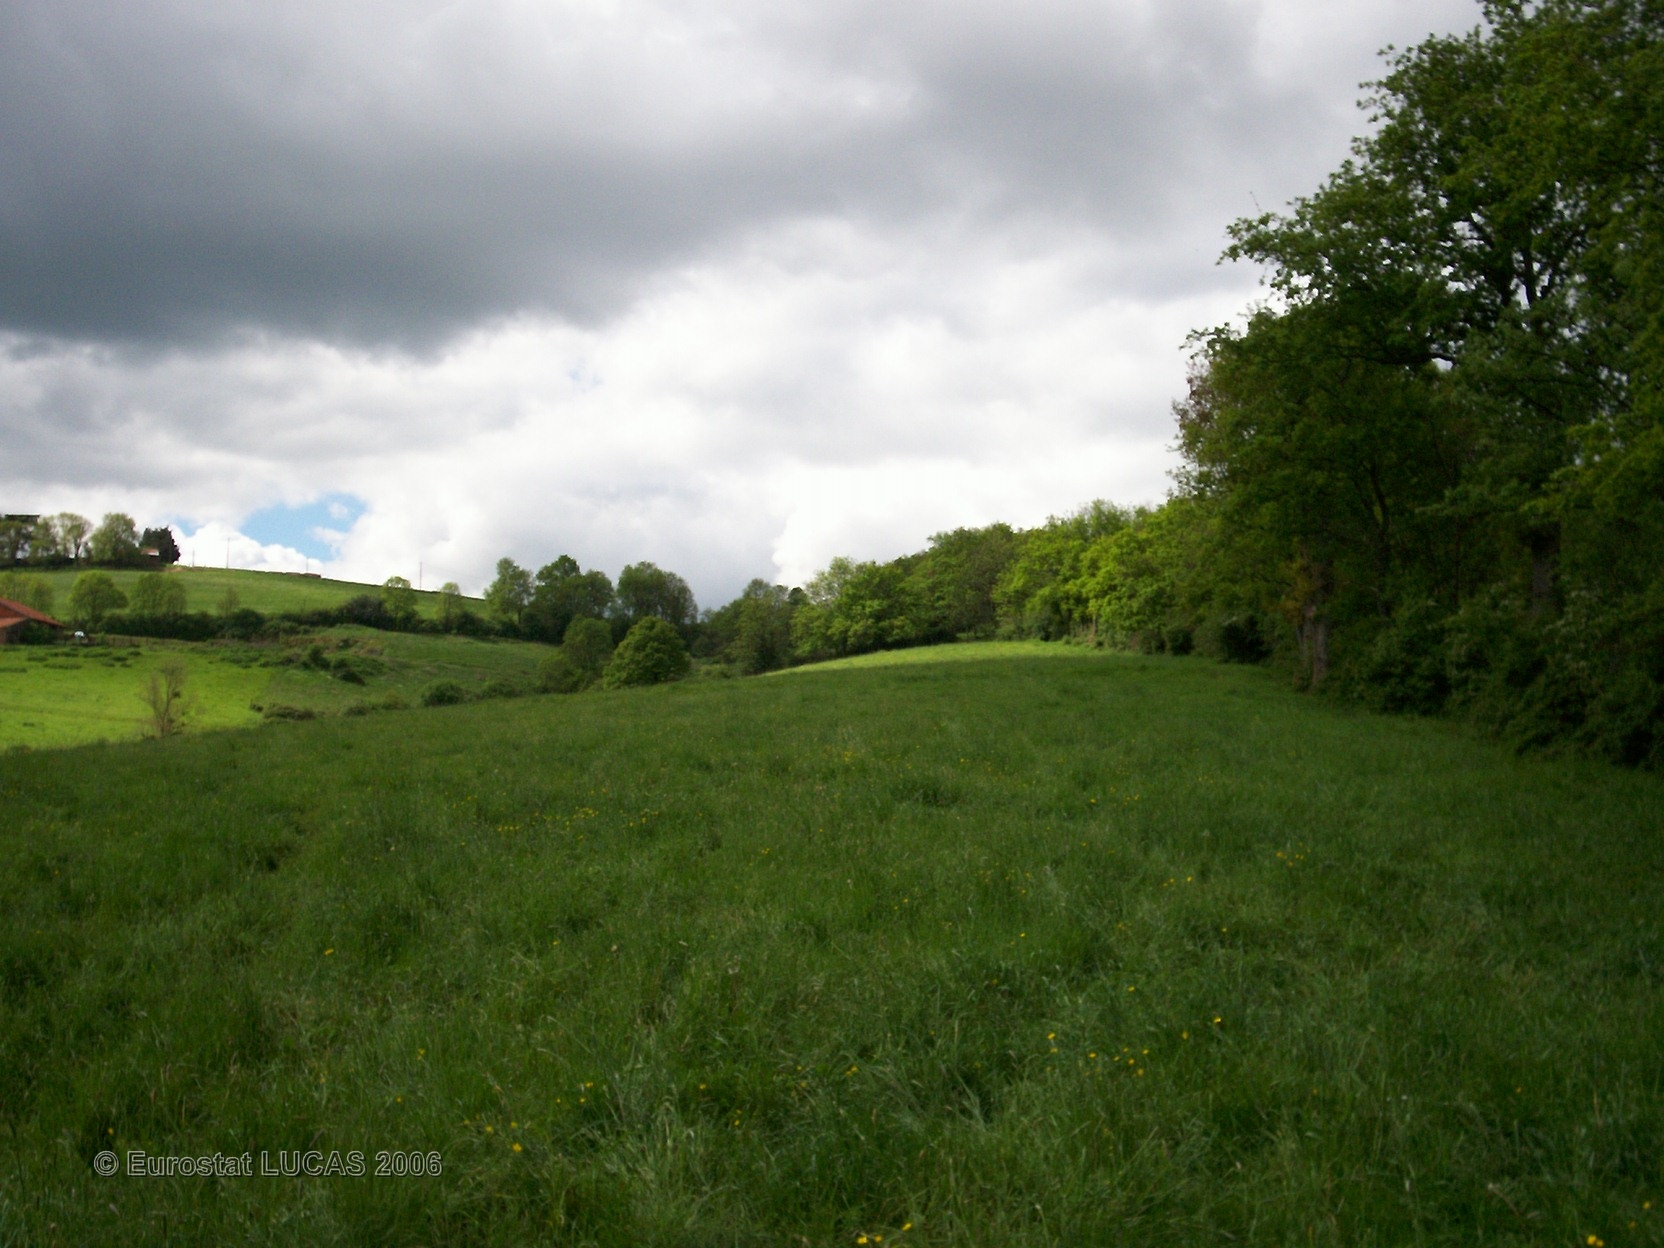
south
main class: Grassland
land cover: Grassland without tree/shrub cover
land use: Agriculture (excluding fallow land and kitchen gardens)
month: May
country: FR
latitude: 45.9539
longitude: 4.1058
